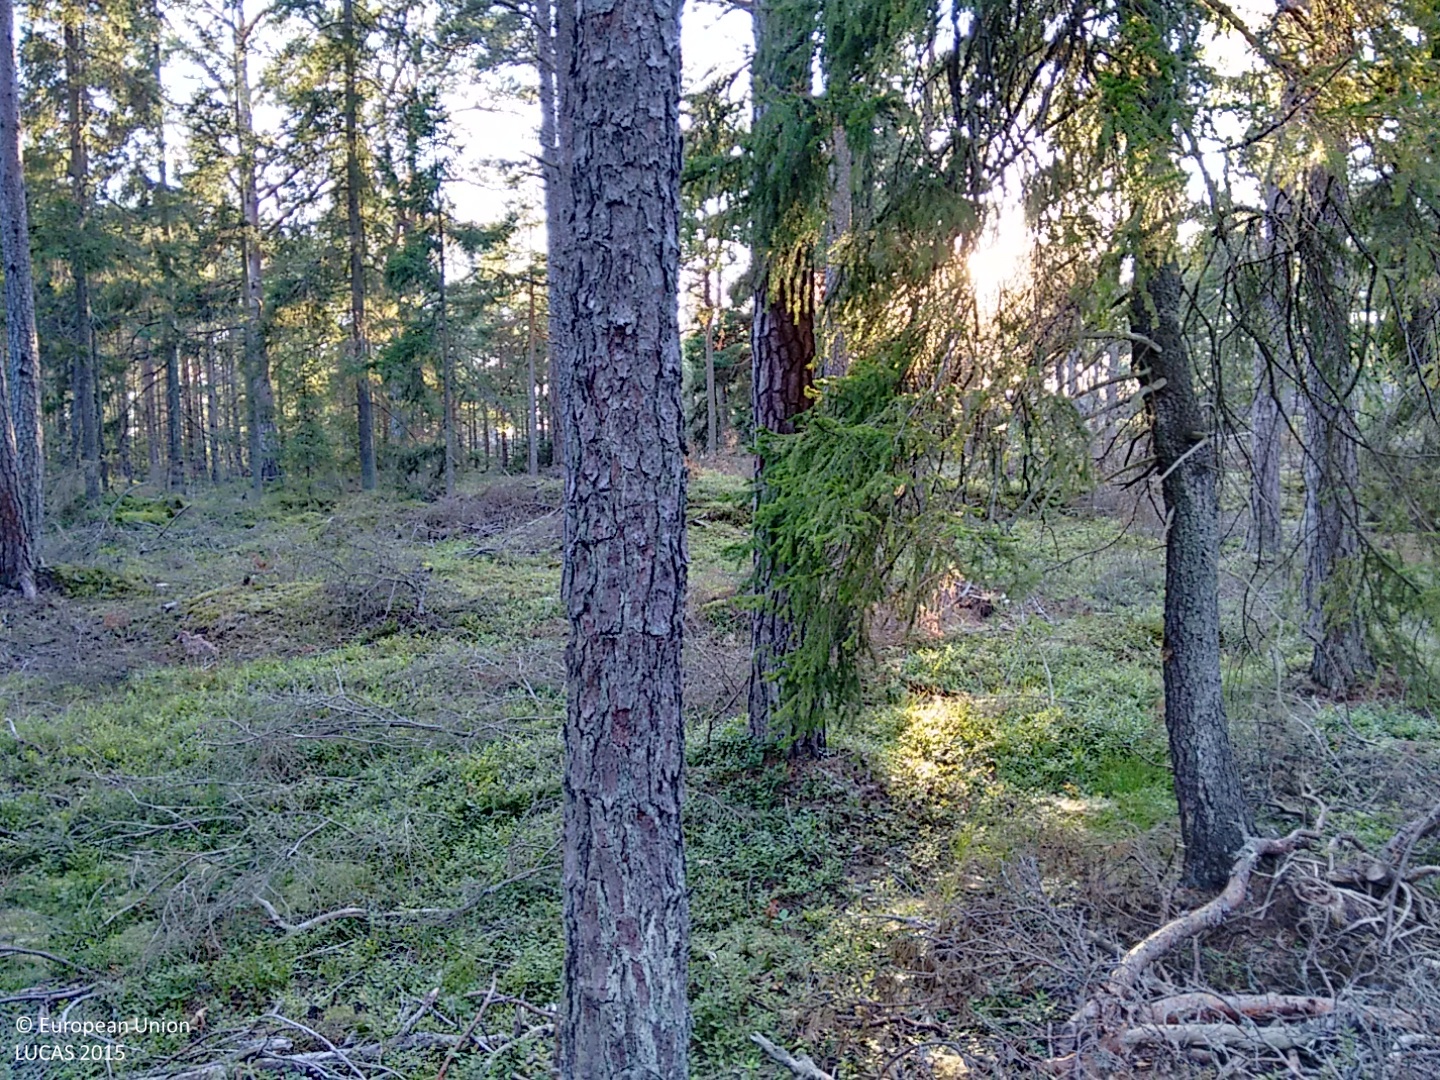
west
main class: Woodland
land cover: Pine dominated coniferous woodland
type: hemiboreal forest and nemoral coniferous forest and mixed broadleaved-coniferous forest
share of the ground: > 75 %
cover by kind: coniferous forest trees 90 %, shrubs 10 %
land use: Forestry
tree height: > 5 m
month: August
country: FI
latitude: 60.1157
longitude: 19.9934
